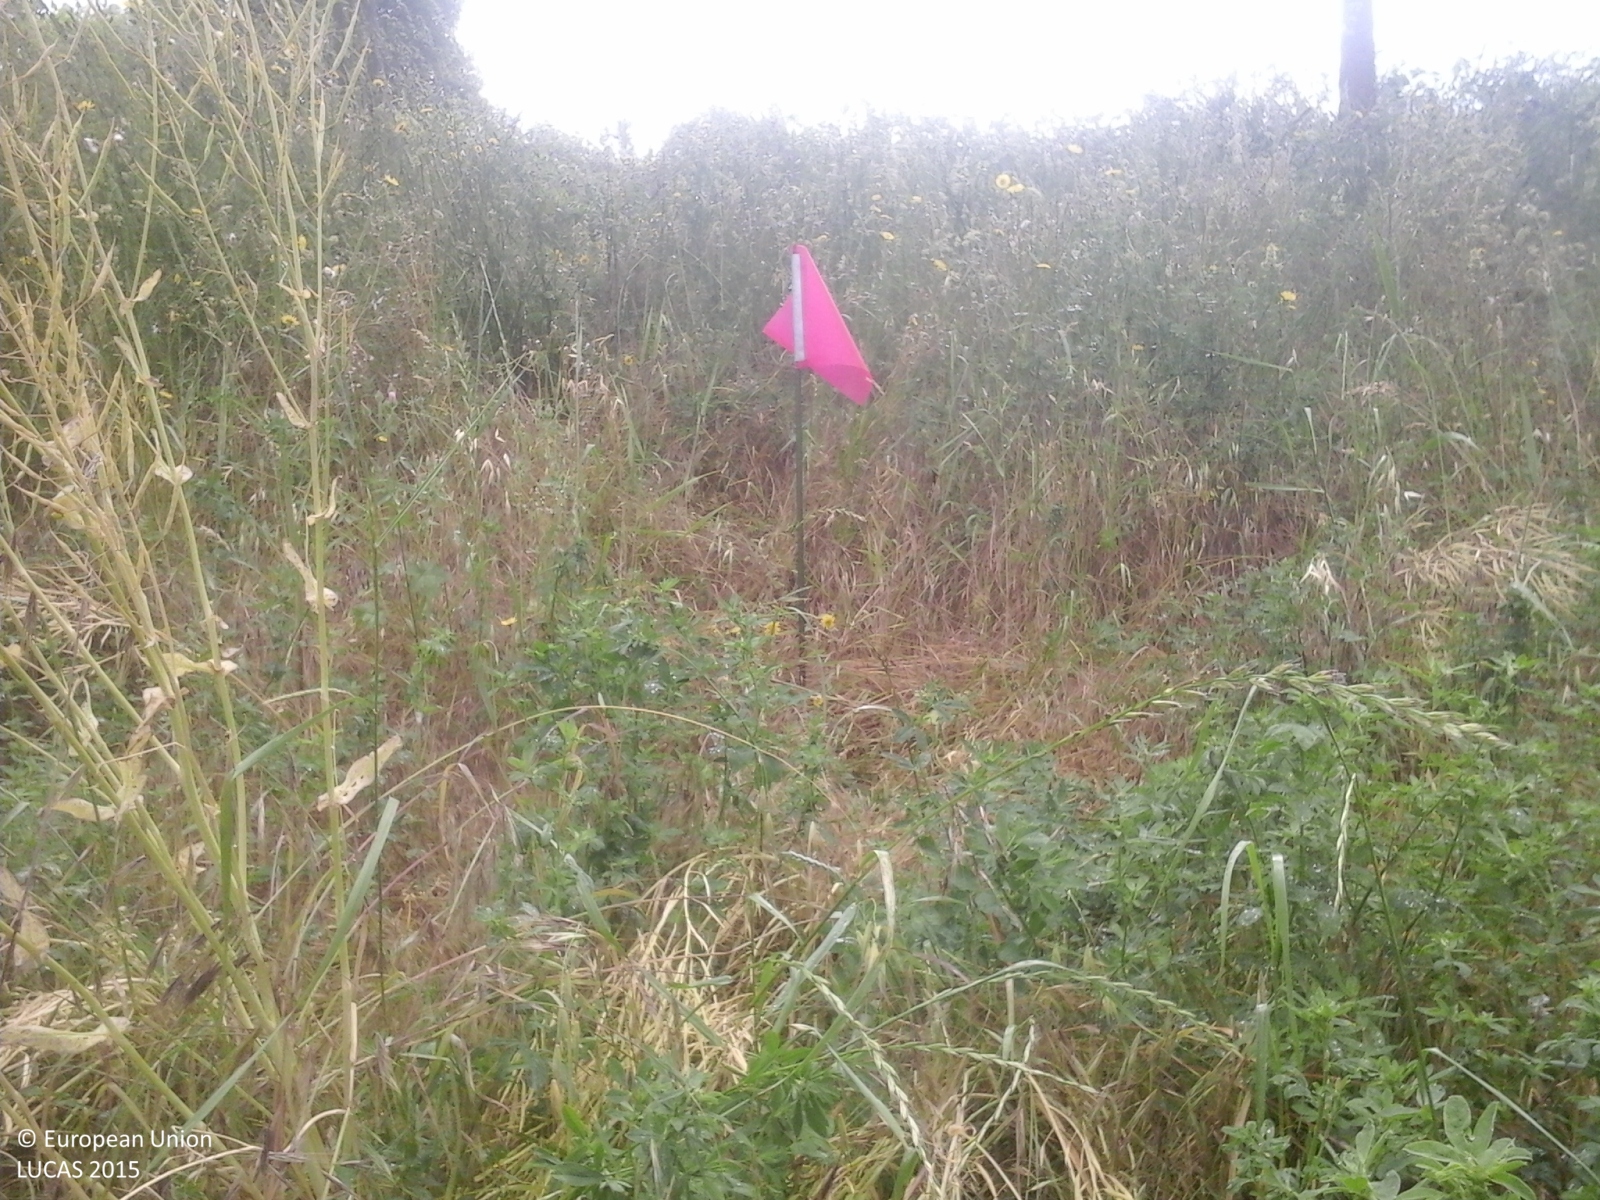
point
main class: Cropland
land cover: Lucerne
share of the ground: > 75 %
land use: Agriculture (excluding fallow land and kitchen gardens)
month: May
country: IT
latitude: 44.2744
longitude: 10.9125
